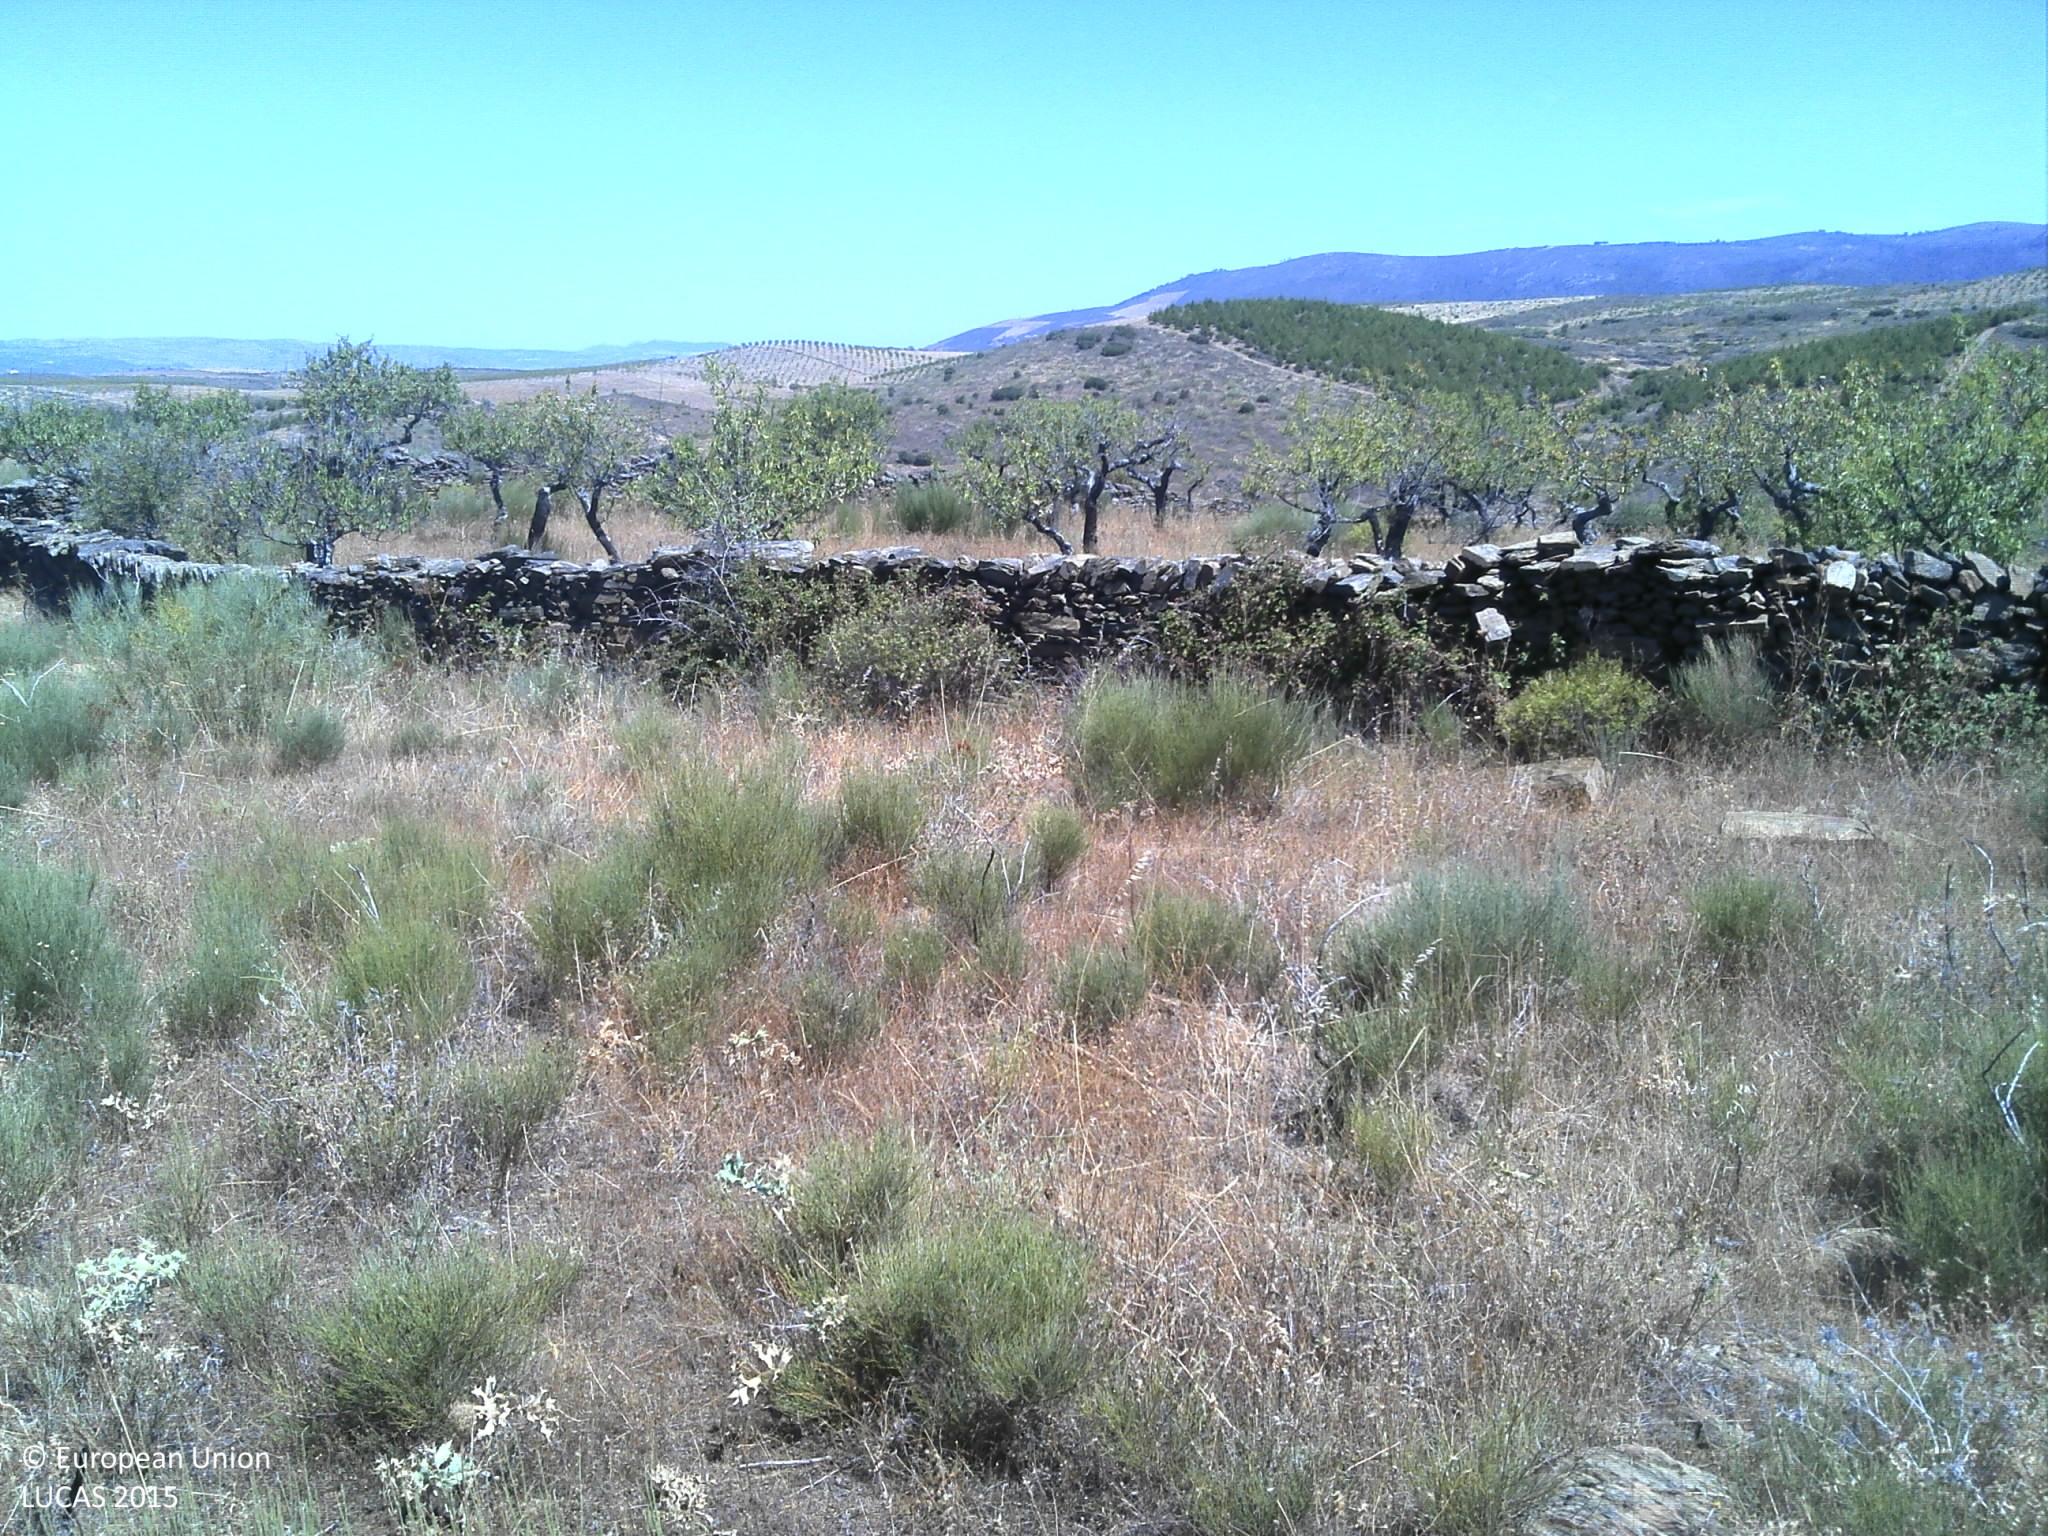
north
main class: Shrubland
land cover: Shrubland without tree cover
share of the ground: 50 - 75 %
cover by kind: shrubs 75 %, herbaceous plants 20 %, consolidated bare surface 5 %
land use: Abandoned areas
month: July
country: PT
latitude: 41.0855
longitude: -7.0486
